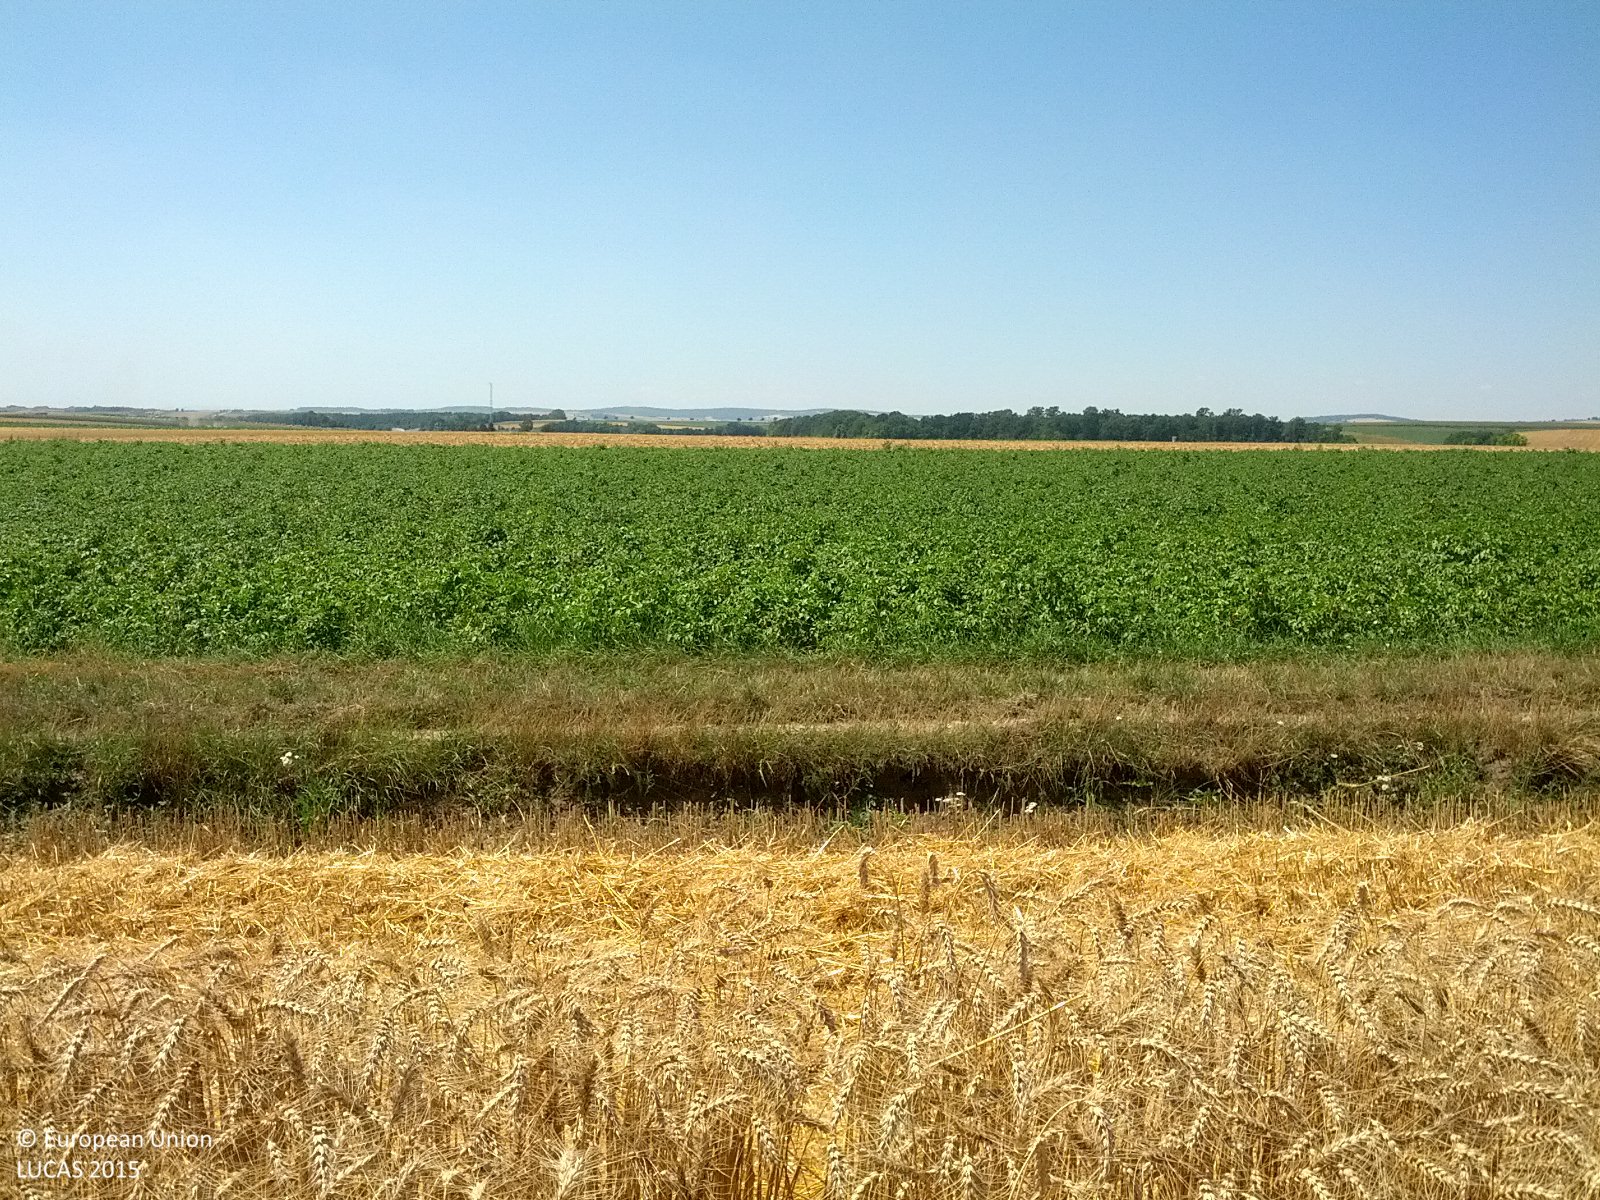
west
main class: Cropland
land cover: Common wheat
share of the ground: > 75 %
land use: Agriculture (excluding fallow land and kitchen gardens)
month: July
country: AT
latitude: 48.4603
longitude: 16.2663
